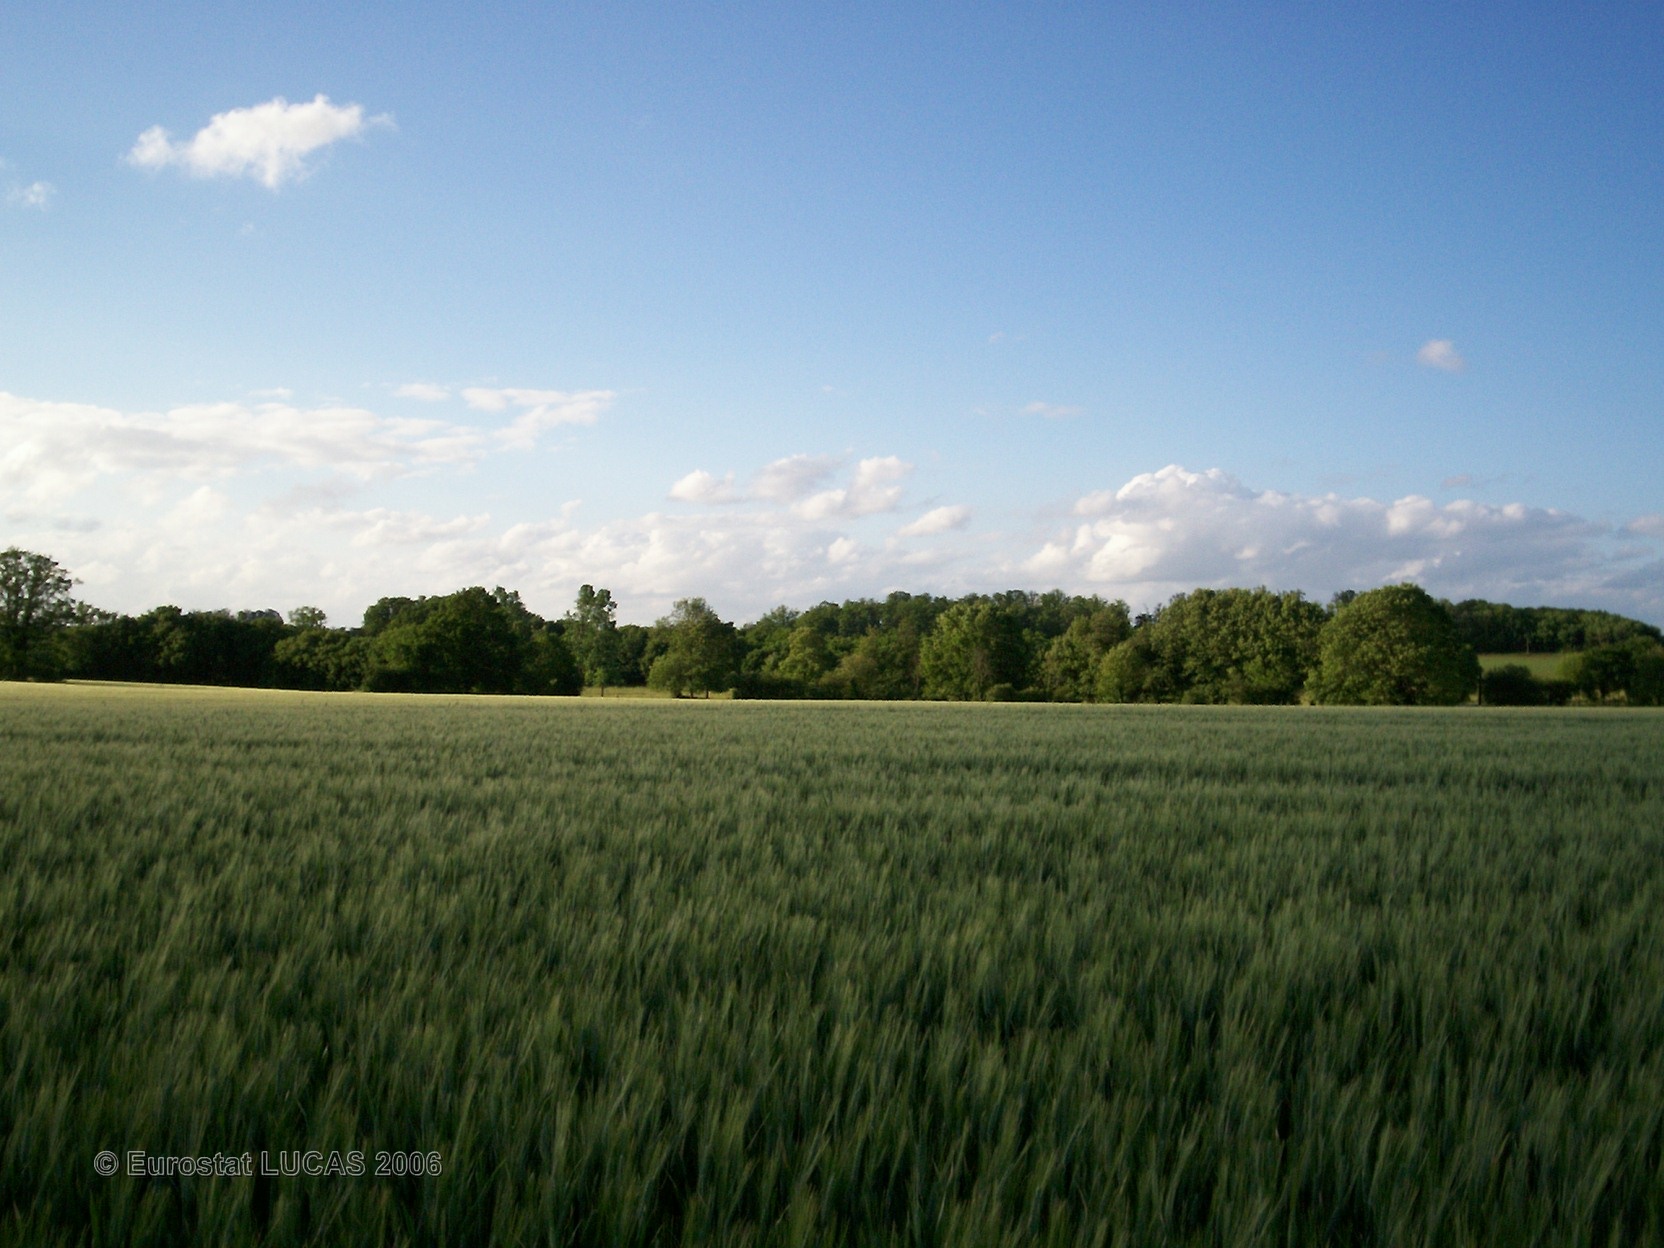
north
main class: Cropland
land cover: Durum wheat
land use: Agriculture (excluding fallow land and kitchen gardens)
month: May
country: FR
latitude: 45.8164
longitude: 0.4745
